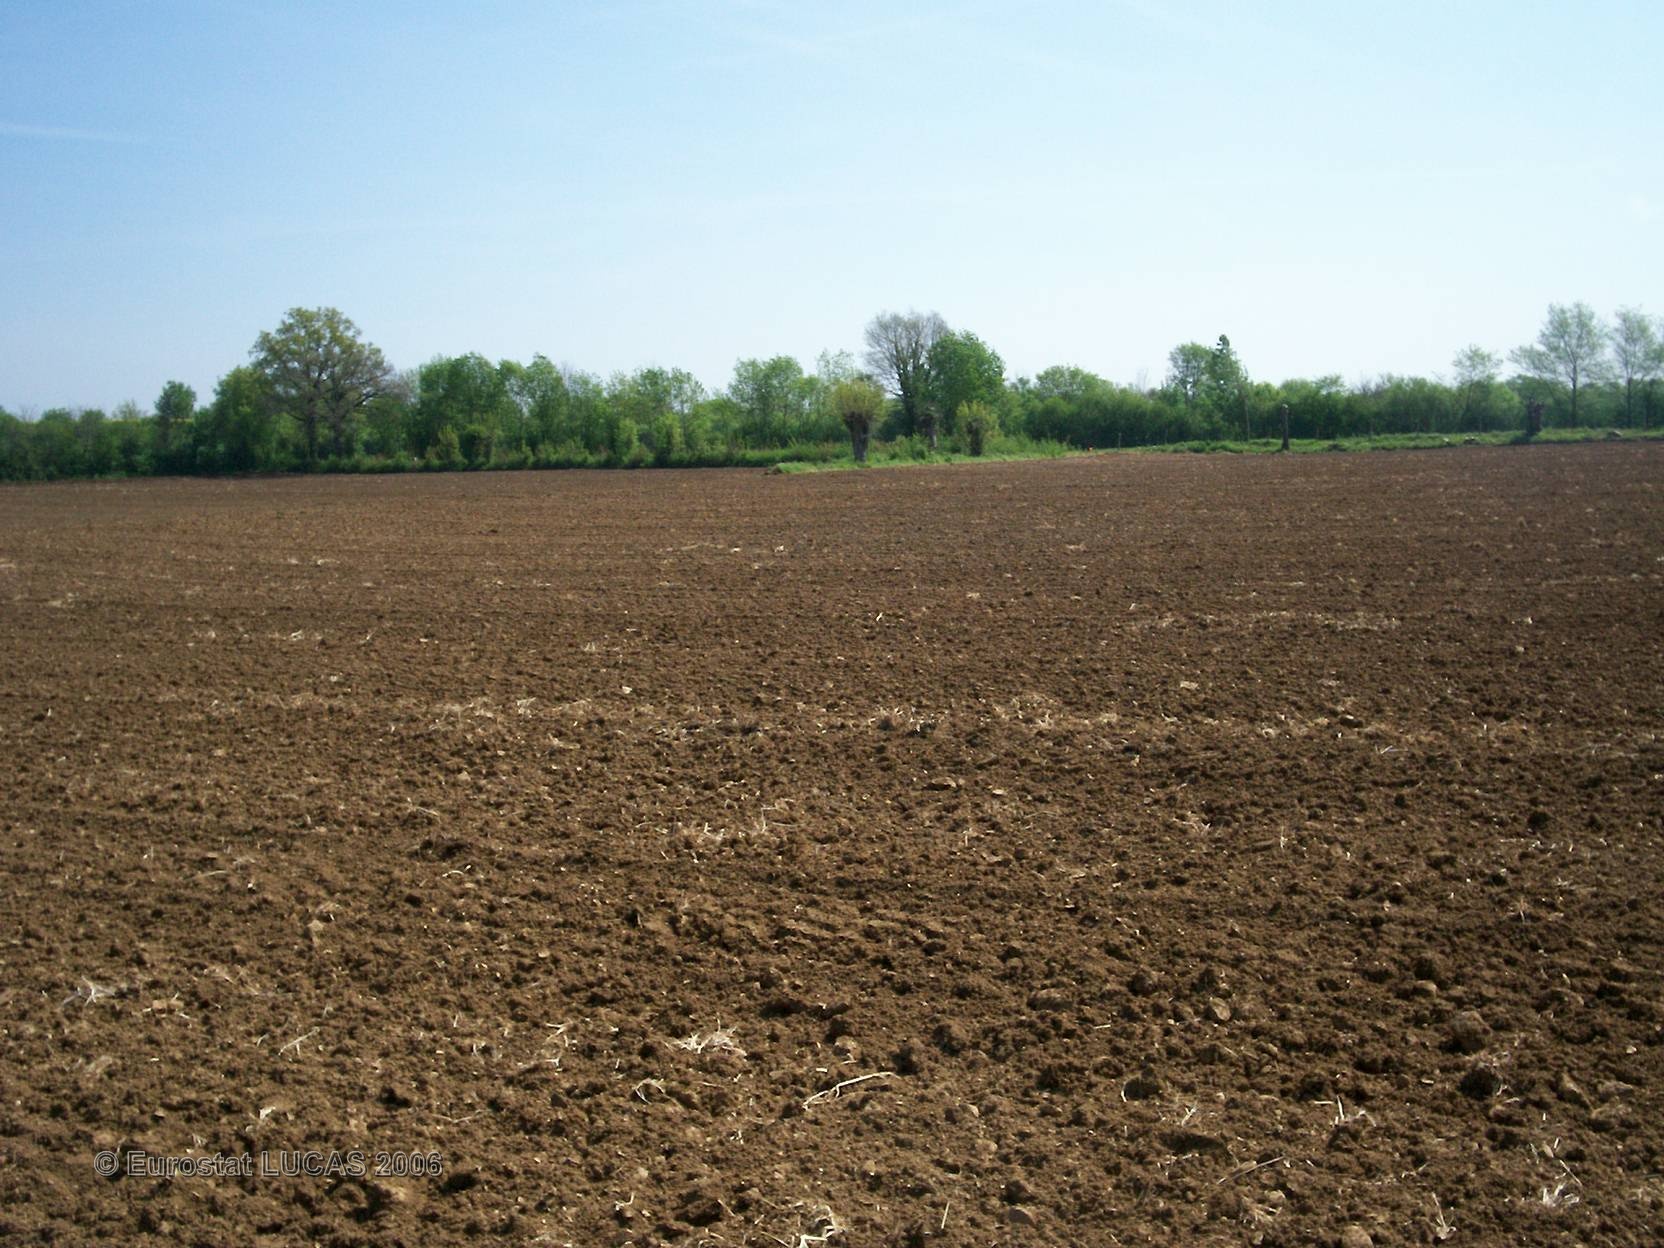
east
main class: Cropland
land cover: Sunflower
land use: Agriculture (excluding fallow land and kitchen gardens)
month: May
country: FR
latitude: 46.1669
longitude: -0.2411
